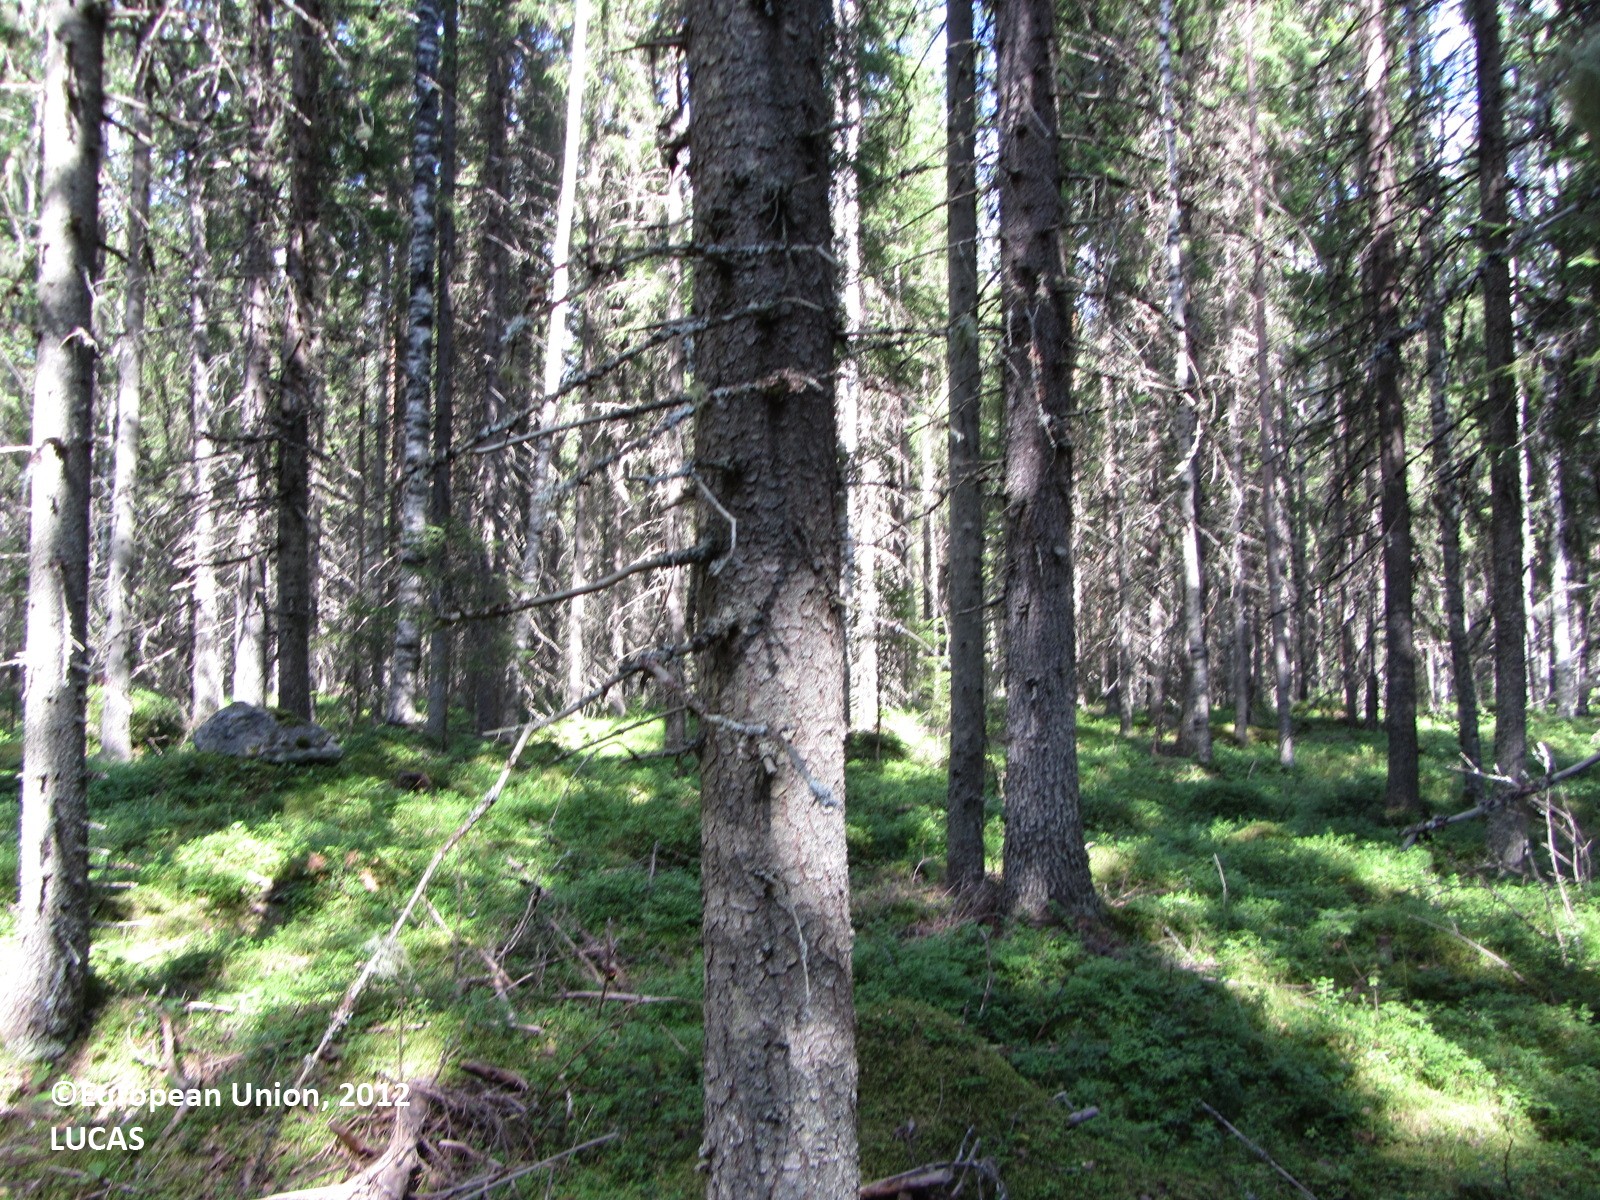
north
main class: Woodland
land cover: Spruce dominated coniferous woodland
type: boreal forest
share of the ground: > 75 %
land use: Forestry
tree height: > 5 m
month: July
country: FI
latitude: 63.5492
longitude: 24.6305
